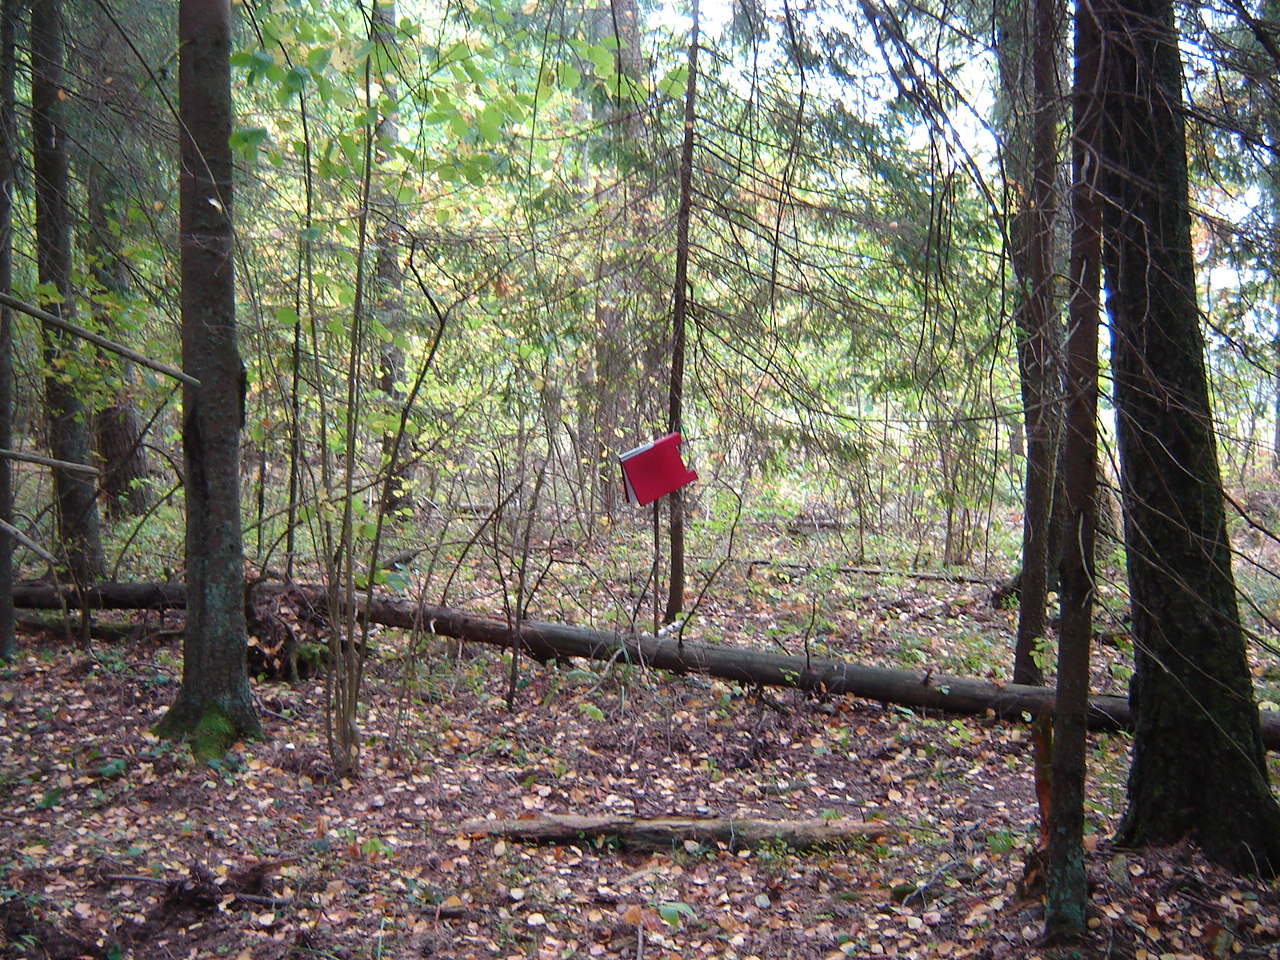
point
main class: Woodland
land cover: Pine dominated mixed woodland
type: hemiboreal forest and nemoral coniferous forest and mixed broadleaved-coniferous forest
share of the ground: > 75 %
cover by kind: coniferous forest trees 60 %, broadleaved forest trees 30 %, herbaceous plants 5 %, unconsolidated bare surface 5 %
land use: Forestry
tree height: > 5 m
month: September
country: LT
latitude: 54.4836
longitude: 25.0733
